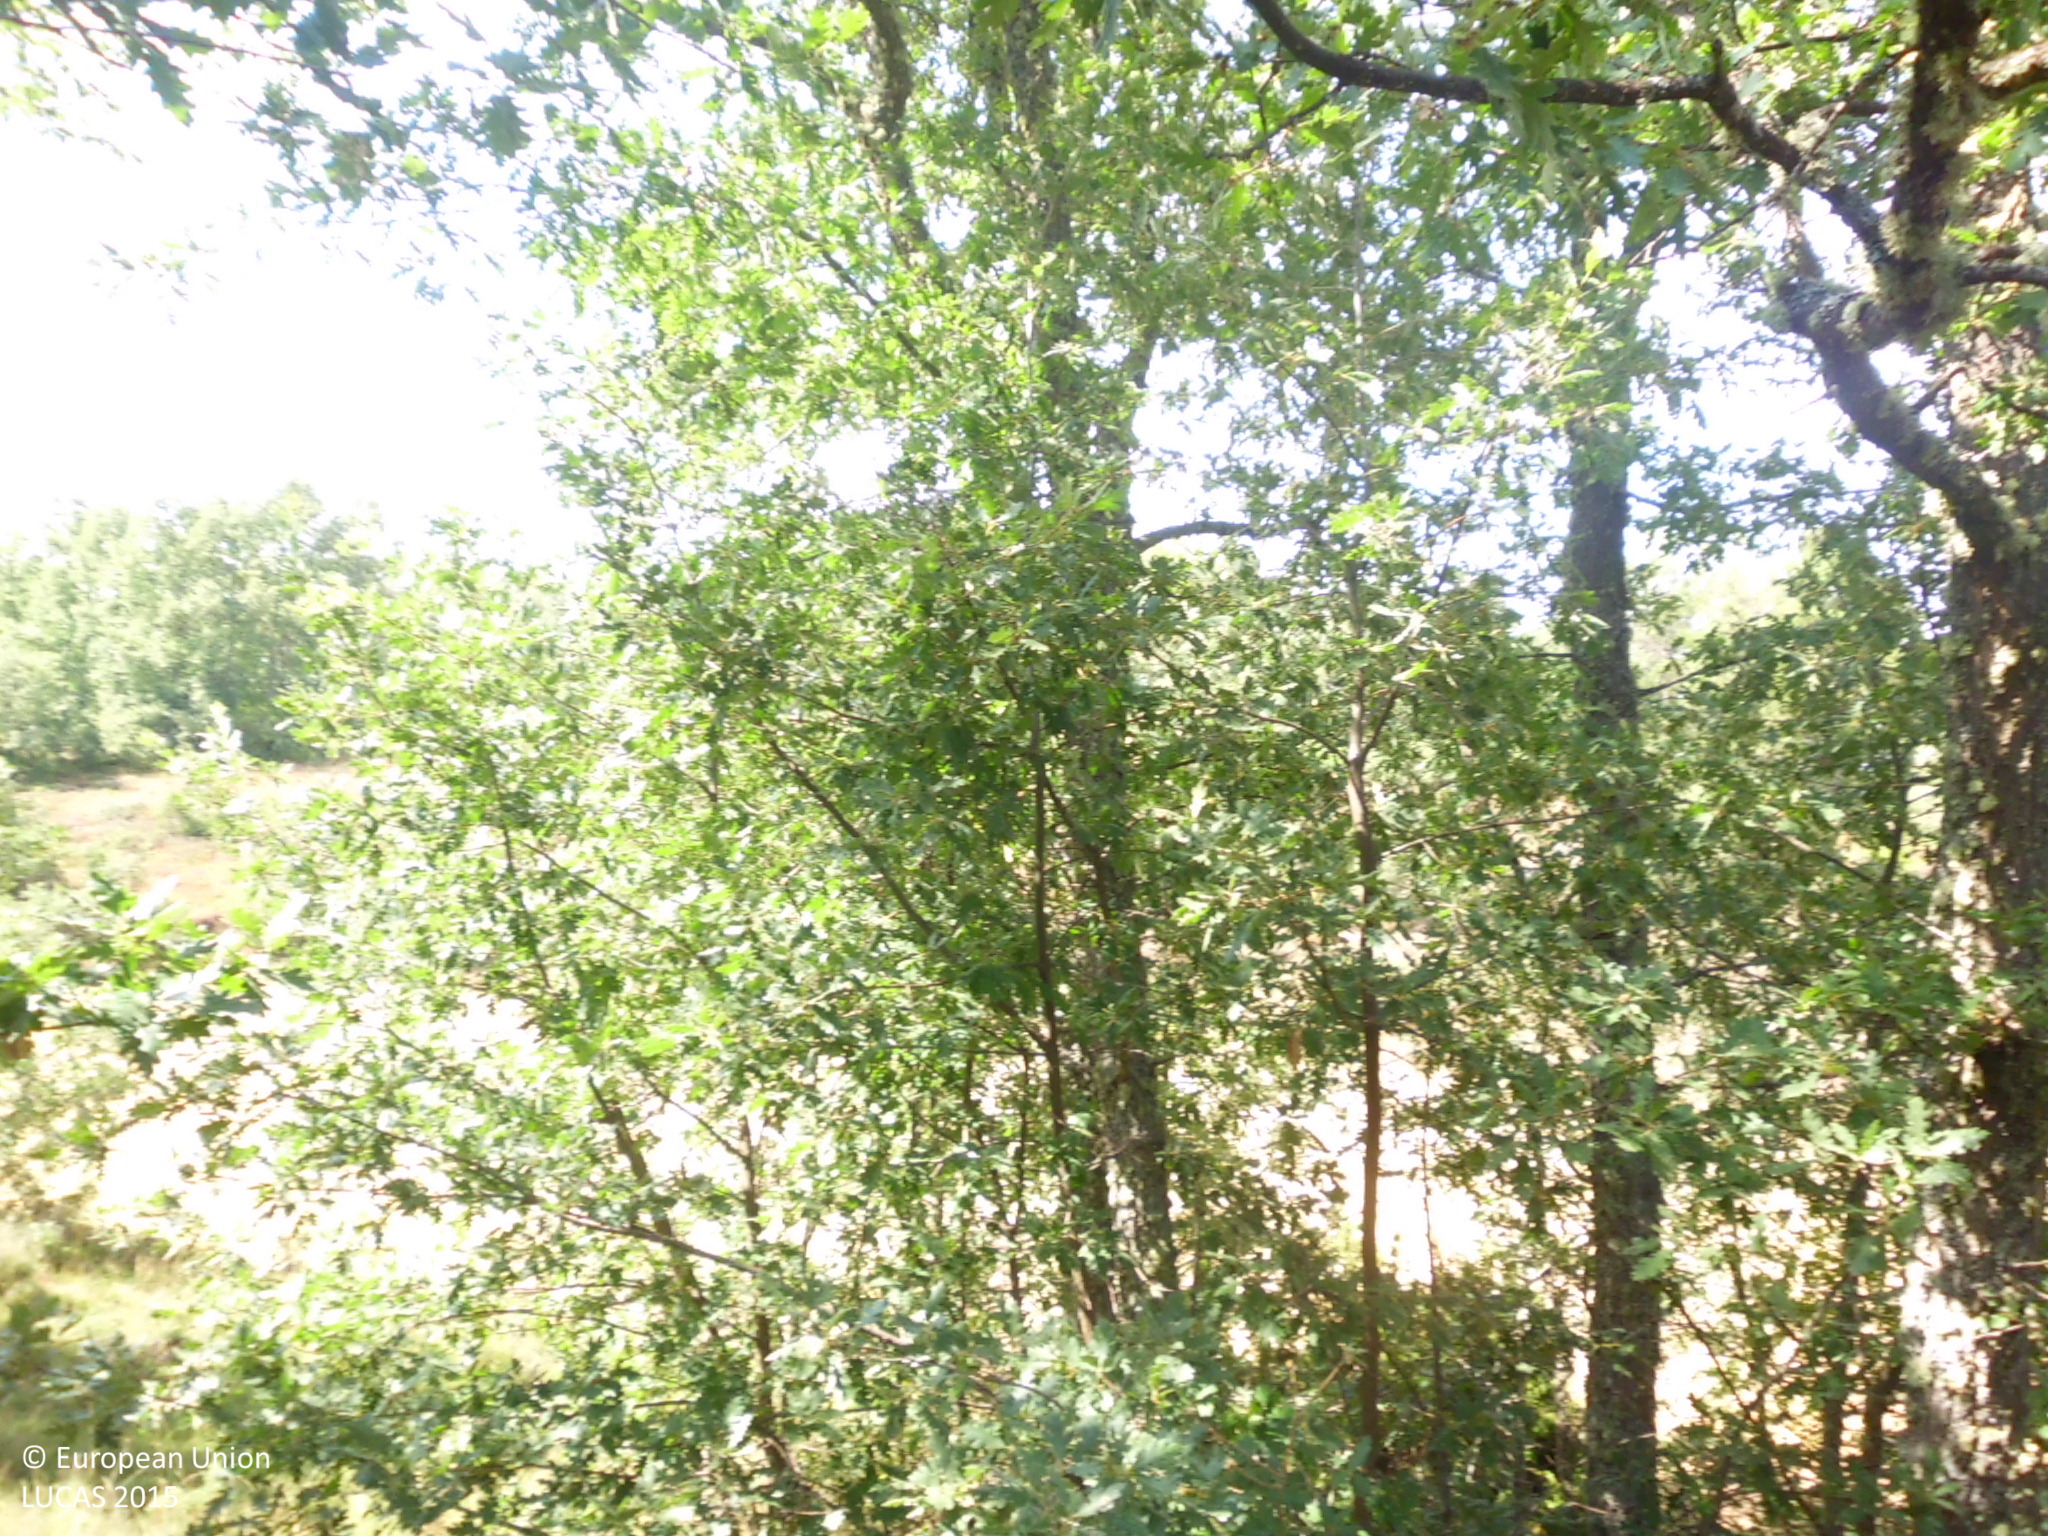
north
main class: Woodland
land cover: Broadleaved woodland
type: acidophilous oak and oak-birch forest
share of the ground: 10 - 25 %
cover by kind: shrubs 70 %, broadleaved forest trees 25 %, herbaceous plants 5 %
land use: Semi-natural and natural areas not in use
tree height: > 5 m
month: July
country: ES
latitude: 42.7427
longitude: -4.4803
